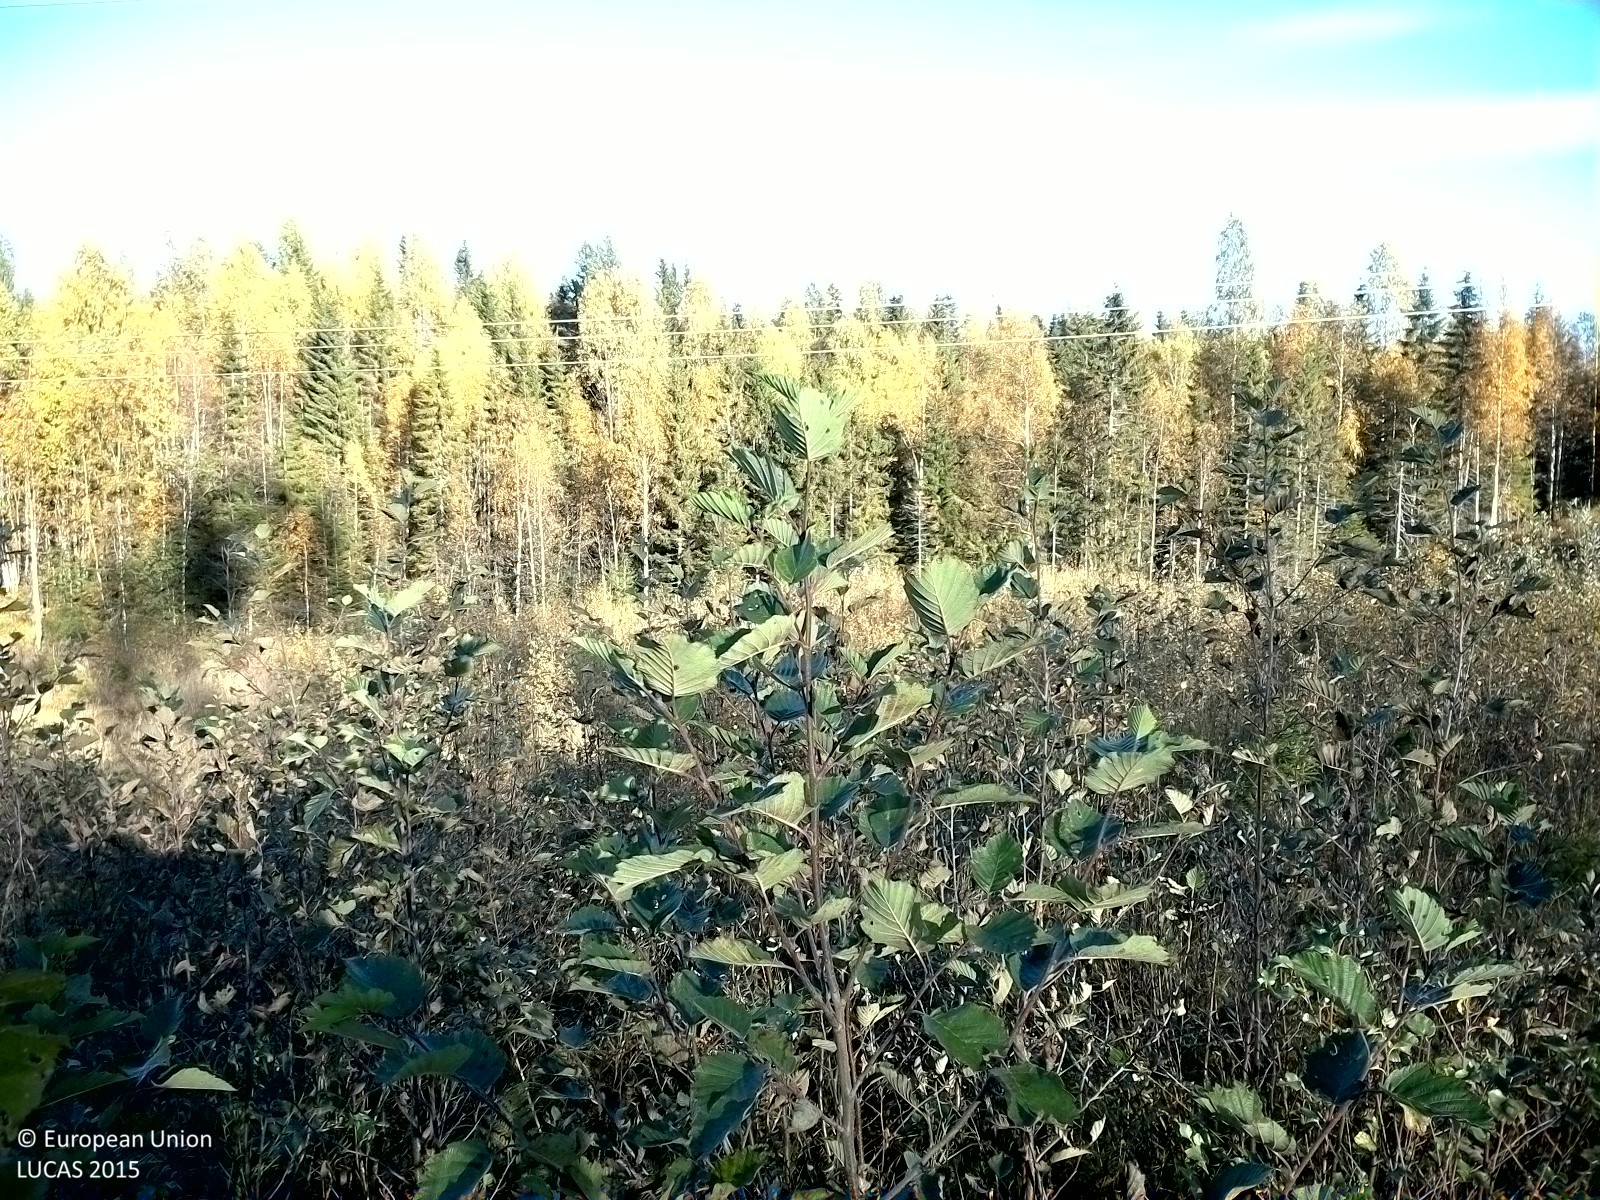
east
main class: Artificial land
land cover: Other artificial areas
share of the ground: > 75 %
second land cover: Broadleaved woodland
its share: > 75 %
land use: Electricity, gas and thermal power distribution
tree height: < 5 m
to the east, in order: Electric lines; Broadleaved woodland; Electric lines; Broadleaved woodland; Other mixed woodland; Rivers and streams; Other mixed woodland; Spruce dominated mixed woodland; Spruce dominated coniferous woodland
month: September
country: SE
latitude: 62.3987
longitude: 16.9255
